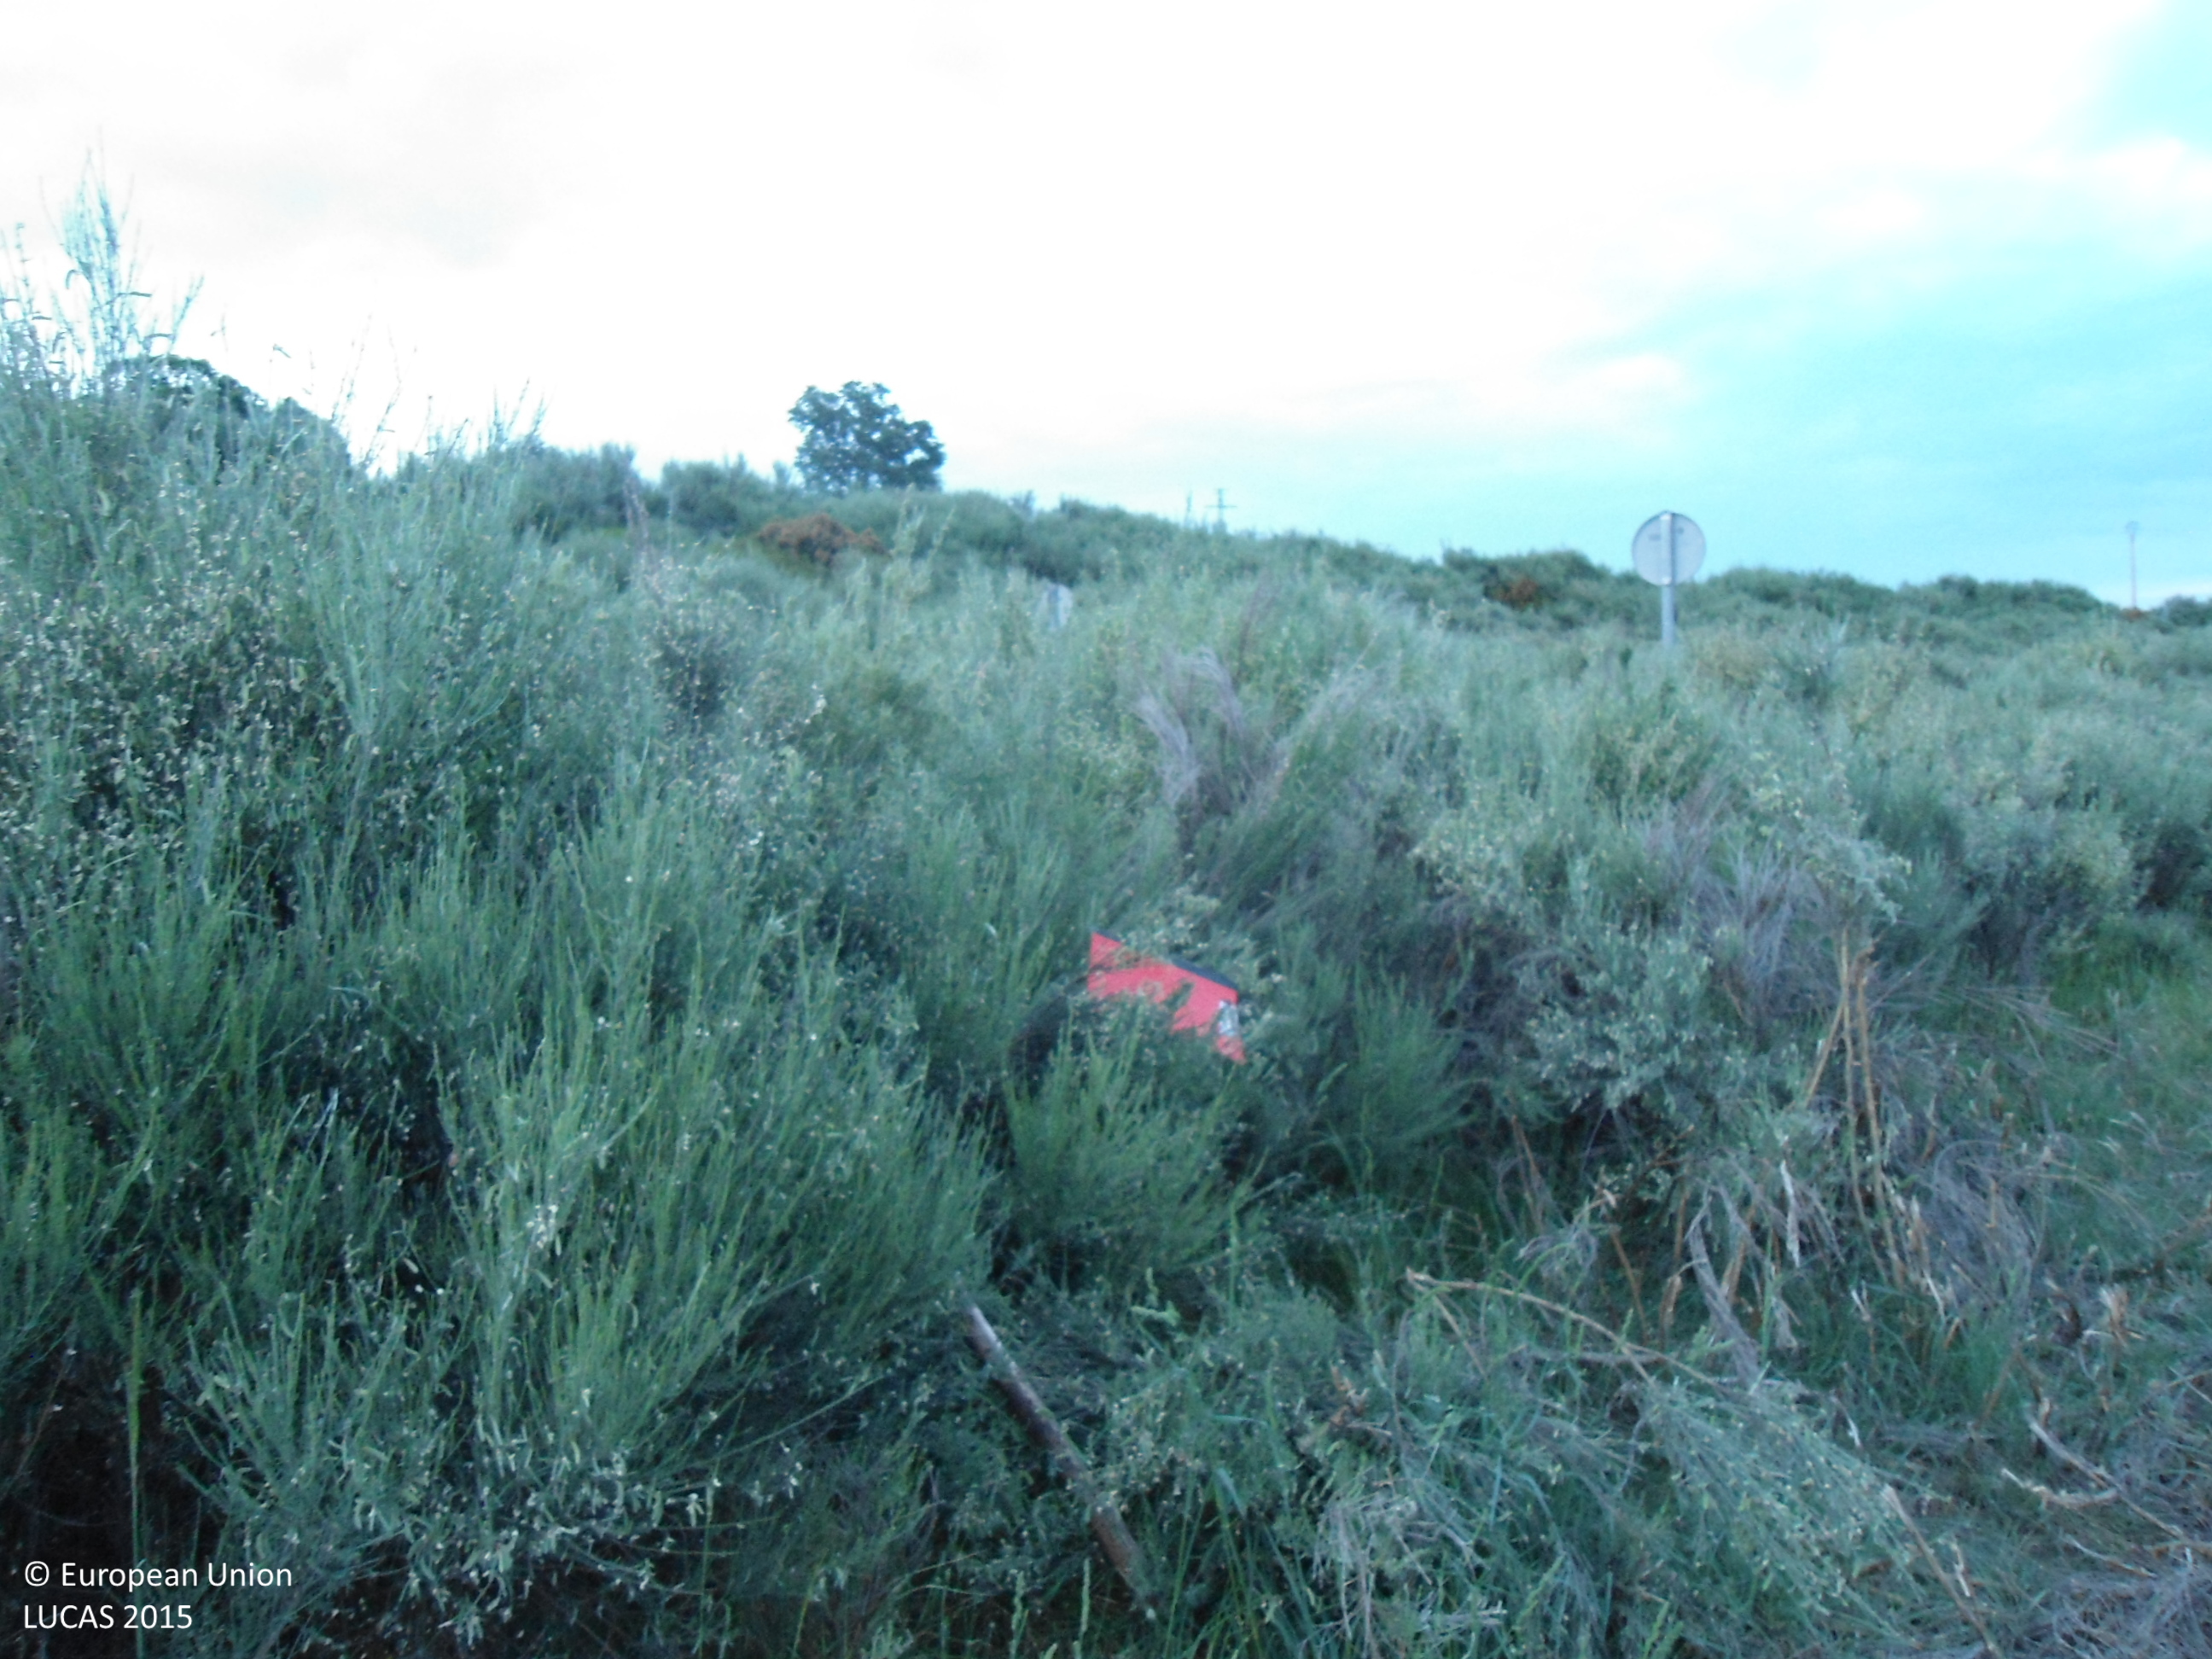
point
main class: Shrubland
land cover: Shrubland without tree cover
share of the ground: > 75 %
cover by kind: shrubs 100 %
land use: Semi-natural and natural areas not in use
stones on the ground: < 10 %
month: June
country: ES
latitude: 42.1505
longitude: -6.6334
